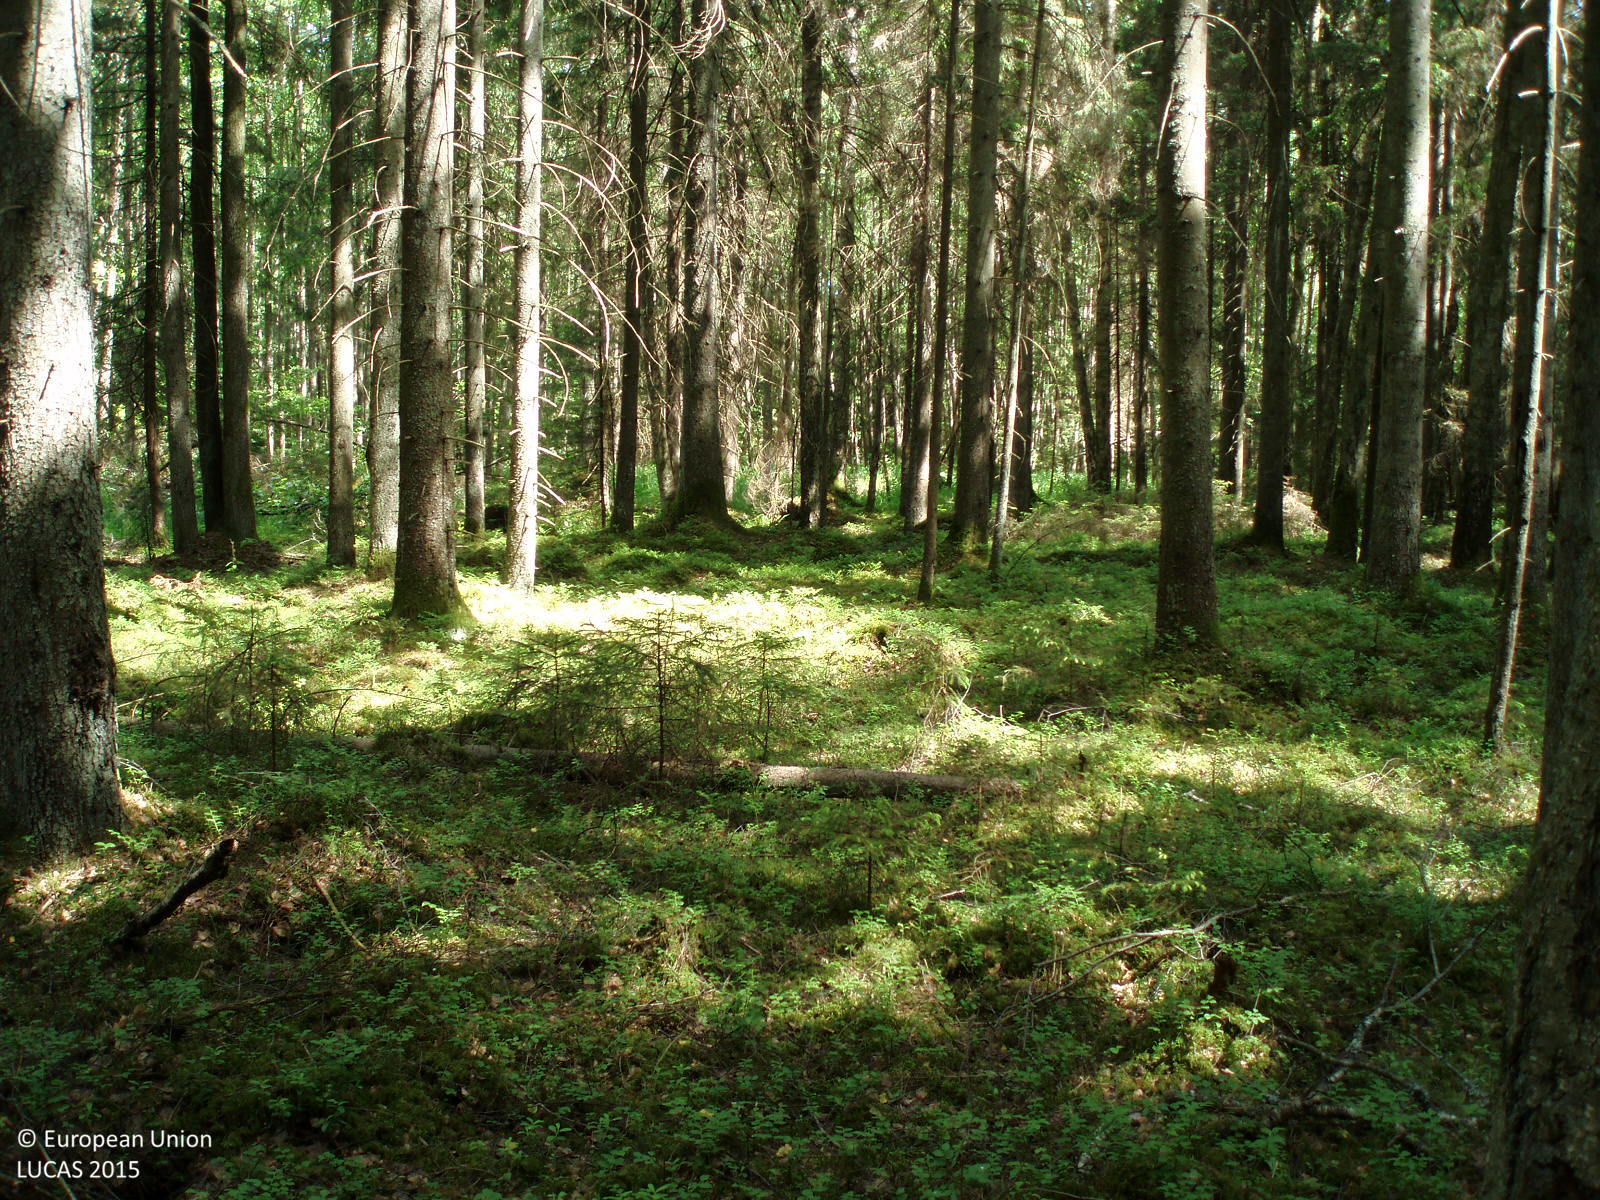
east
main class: Woodland
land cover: Spruce dominated coniferous woodland
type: hemiboreal forest and nemoral coniferous forest and mixed broadleaved-coniferous forest
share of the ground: > 75 %
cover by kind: coniferous forest trees 60 %, broadleaved forest trees 20 %, herbaceous plants 10 %, lichens and mosses 10 %
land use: Forestry
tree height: > 5 m
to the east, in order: Spruce dominated coniferous woodland; Broadleaved woodland; Spruce dominated mixed woodland
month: June
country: LT
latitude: 55.1570
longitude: 22.4760
